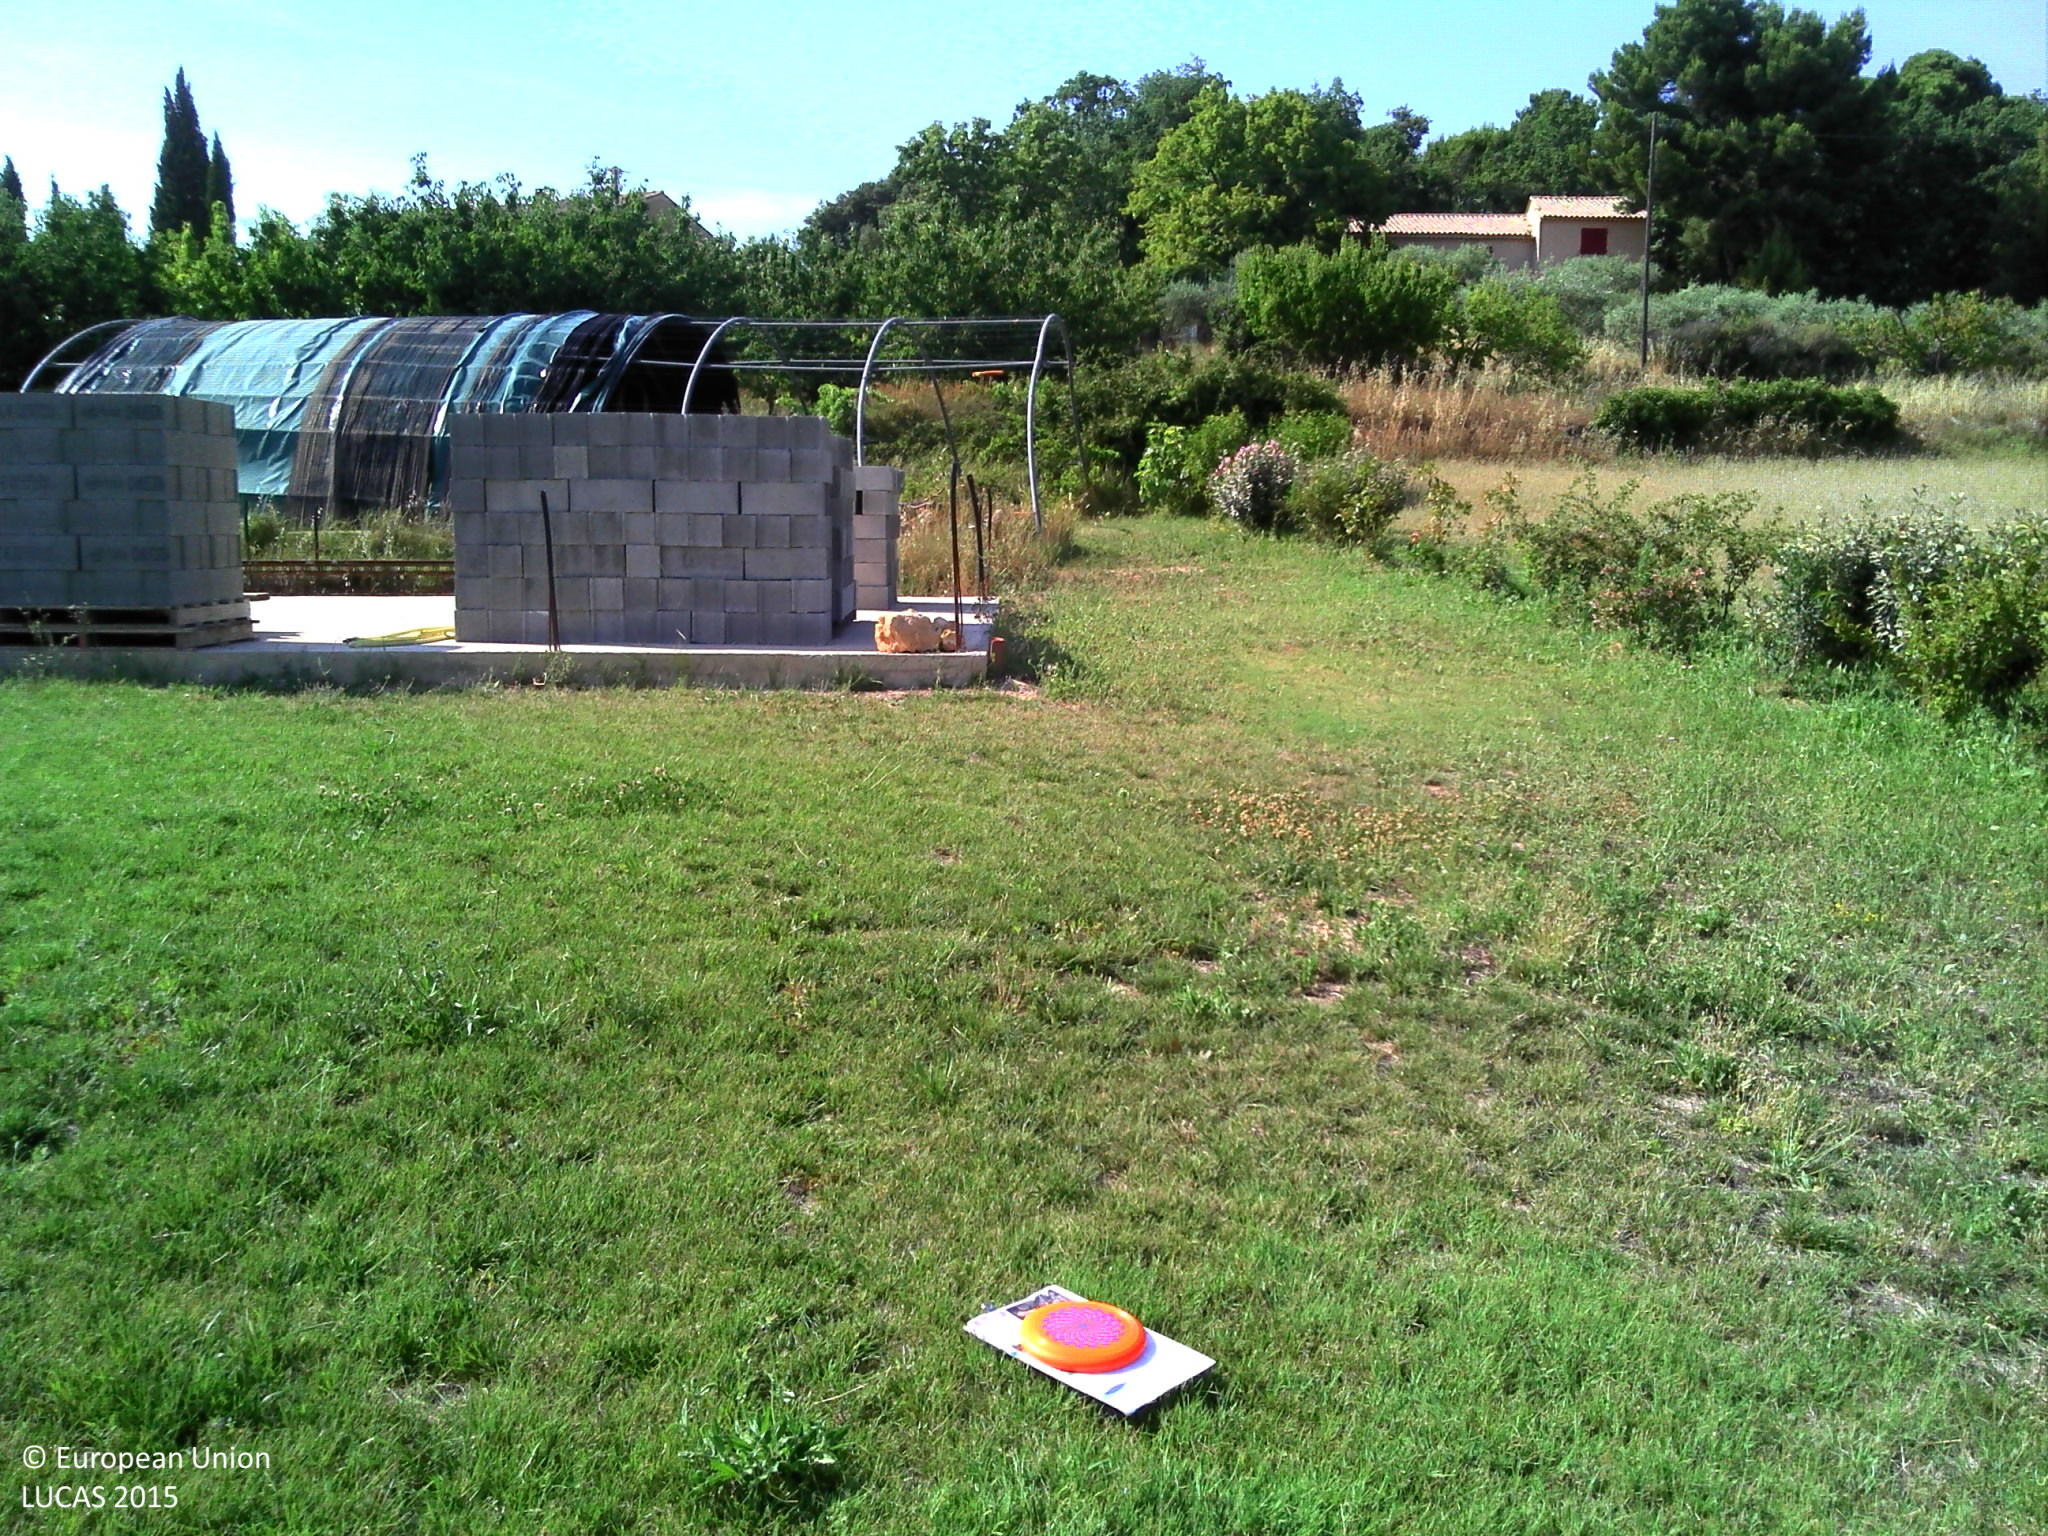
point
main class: Grassland
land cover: Grassland without tree/shrub cover
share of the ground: > 75 %
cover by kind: herbaceous plants 100 %
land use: Residential
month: July
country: FR
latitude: 44.1443
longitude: 5.0950
